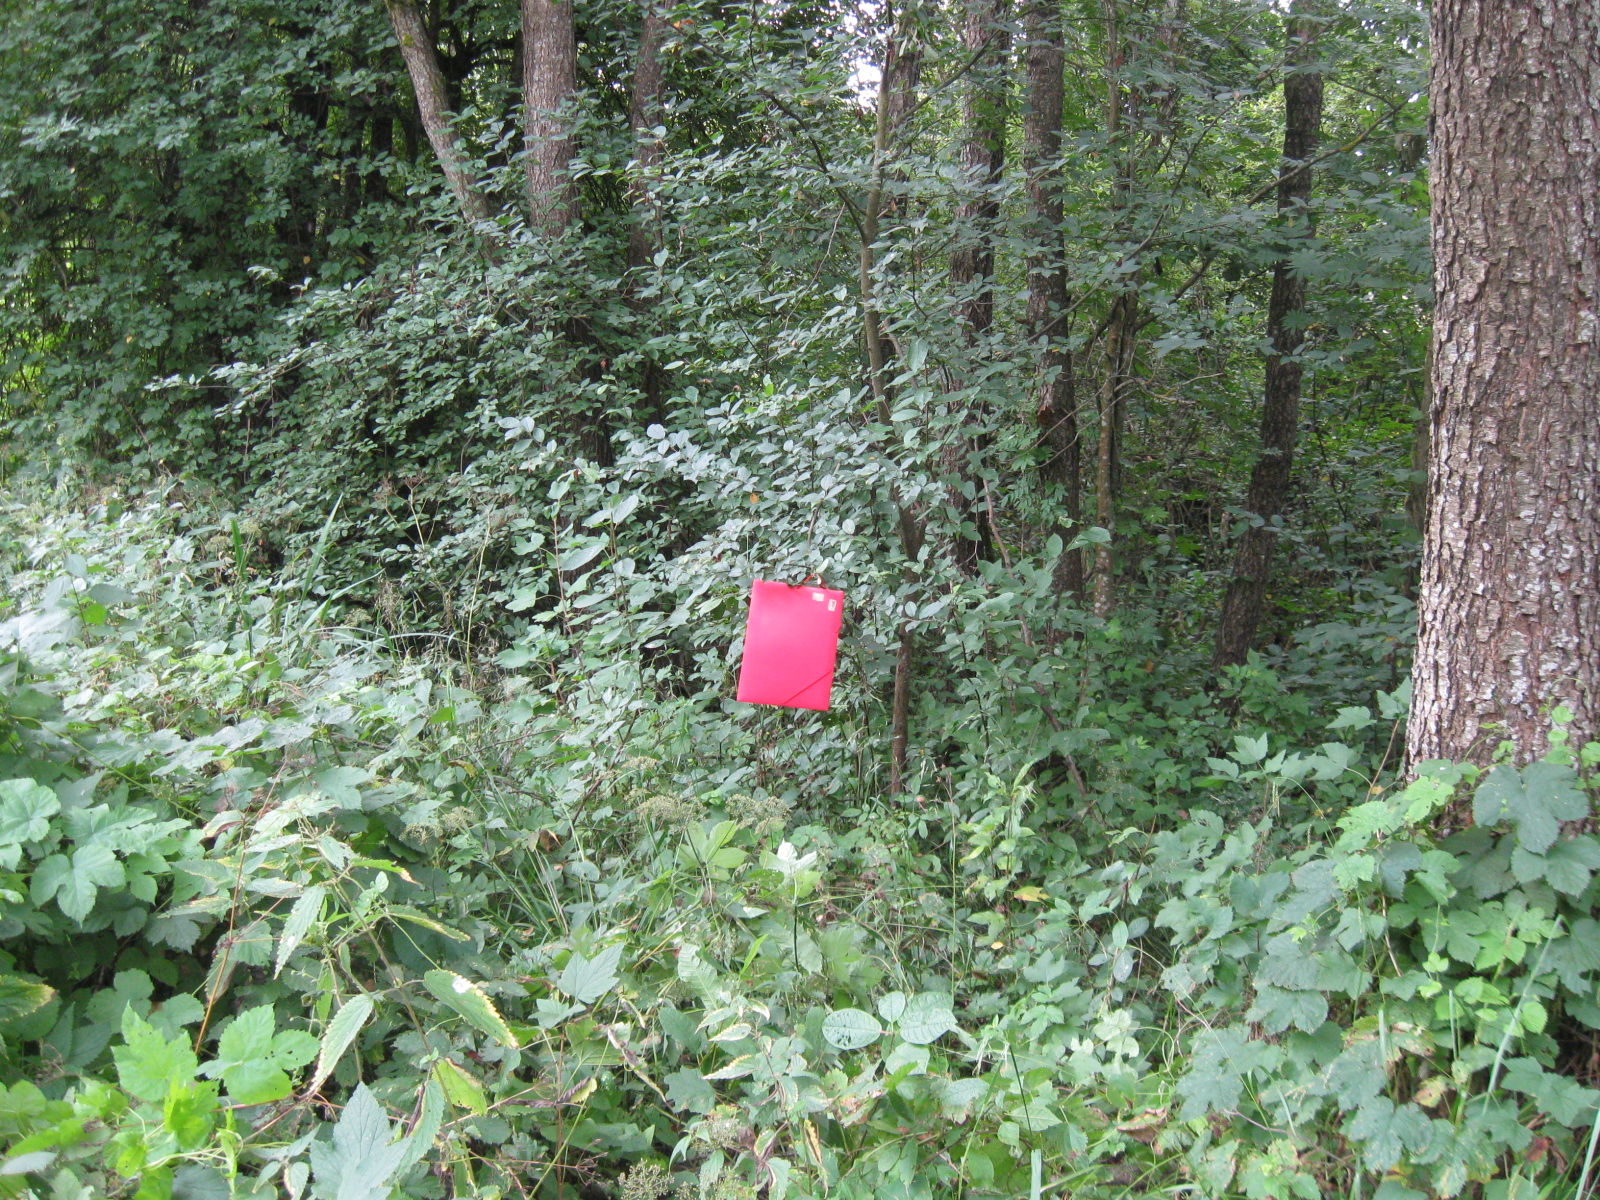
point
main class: Woodland
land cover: Broadleaved woodland
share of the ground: > 75 %
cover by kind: broadleaved forest trees 85 %, herbaceous plants 10 %, shrubs 5 %
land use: Forestry
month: July
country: LT
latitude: 54.4198
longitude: 24.3868
